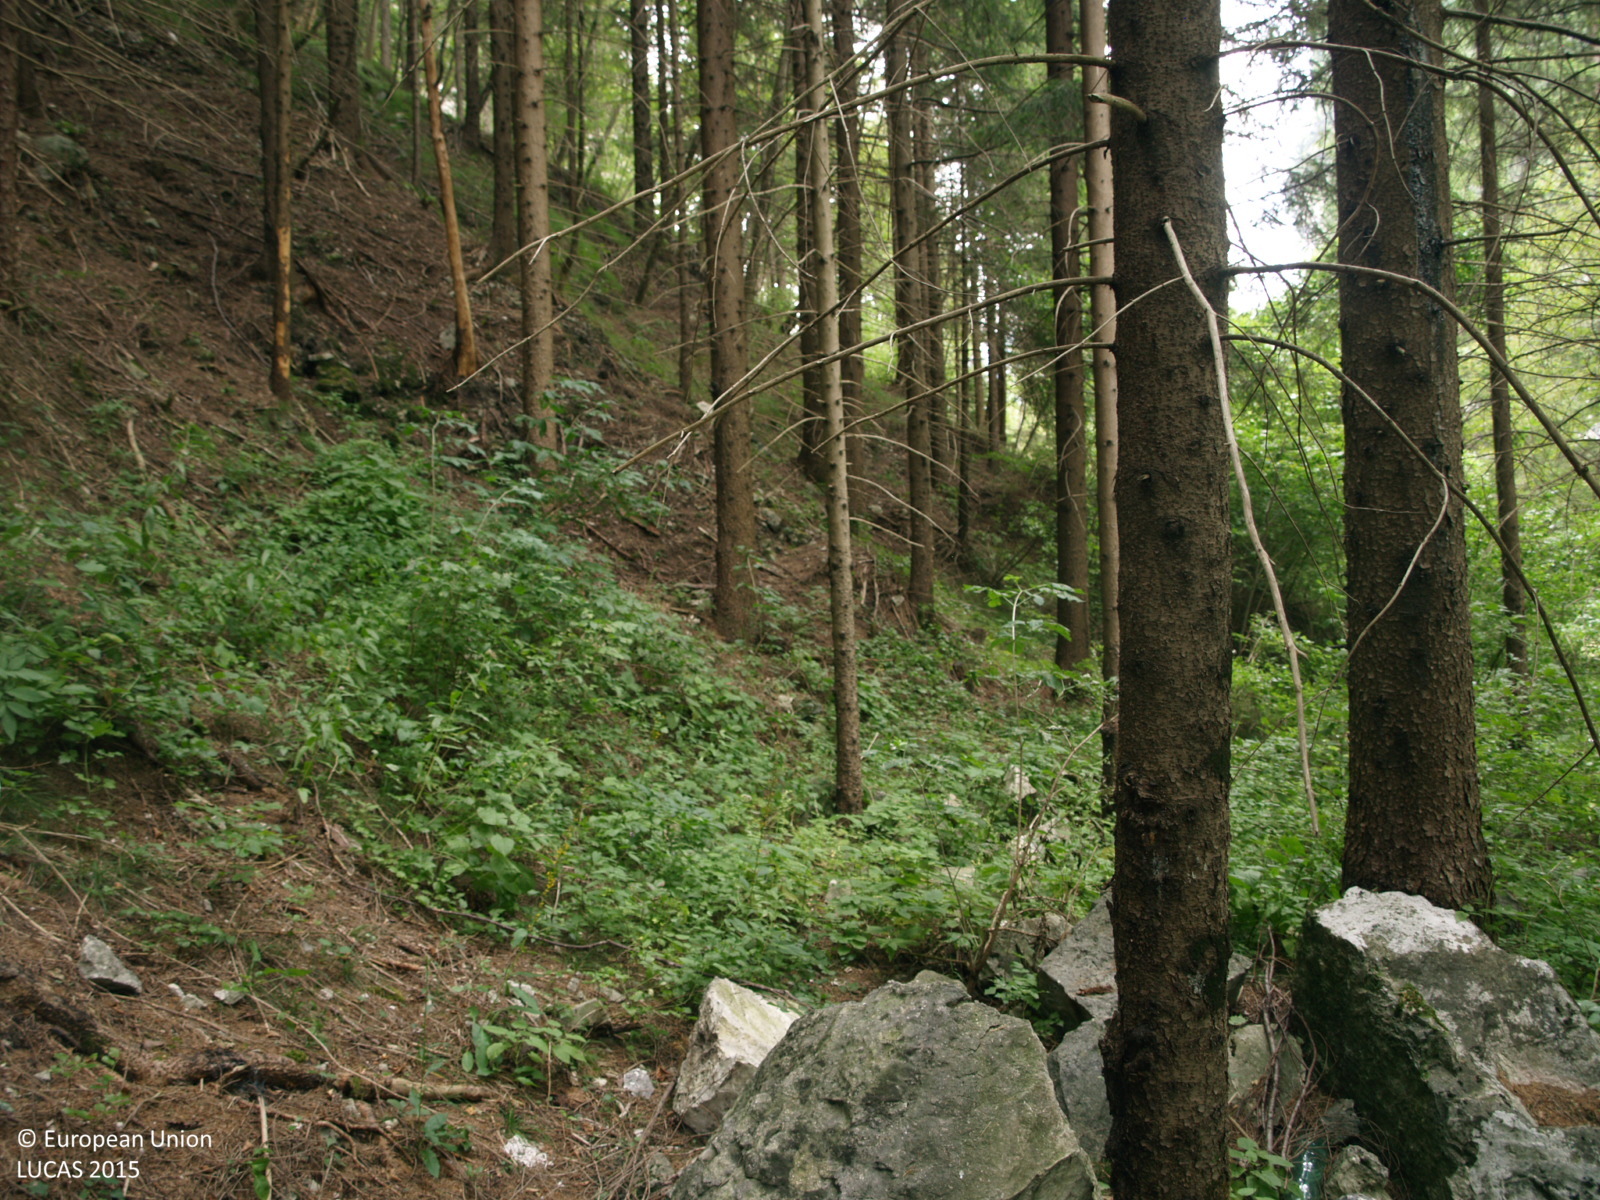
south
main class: Woodland
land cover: Spruce dominated coniferous woodland
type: alpine coniferous forest
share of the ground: > 75 %
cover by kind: coniferous forest trees 90 %, broadleaved forest trees 10 %
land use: Forestry
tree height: > 5 m
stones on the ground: > 50 %
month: May
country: IT
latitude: 46.0784
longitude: 10.7360
